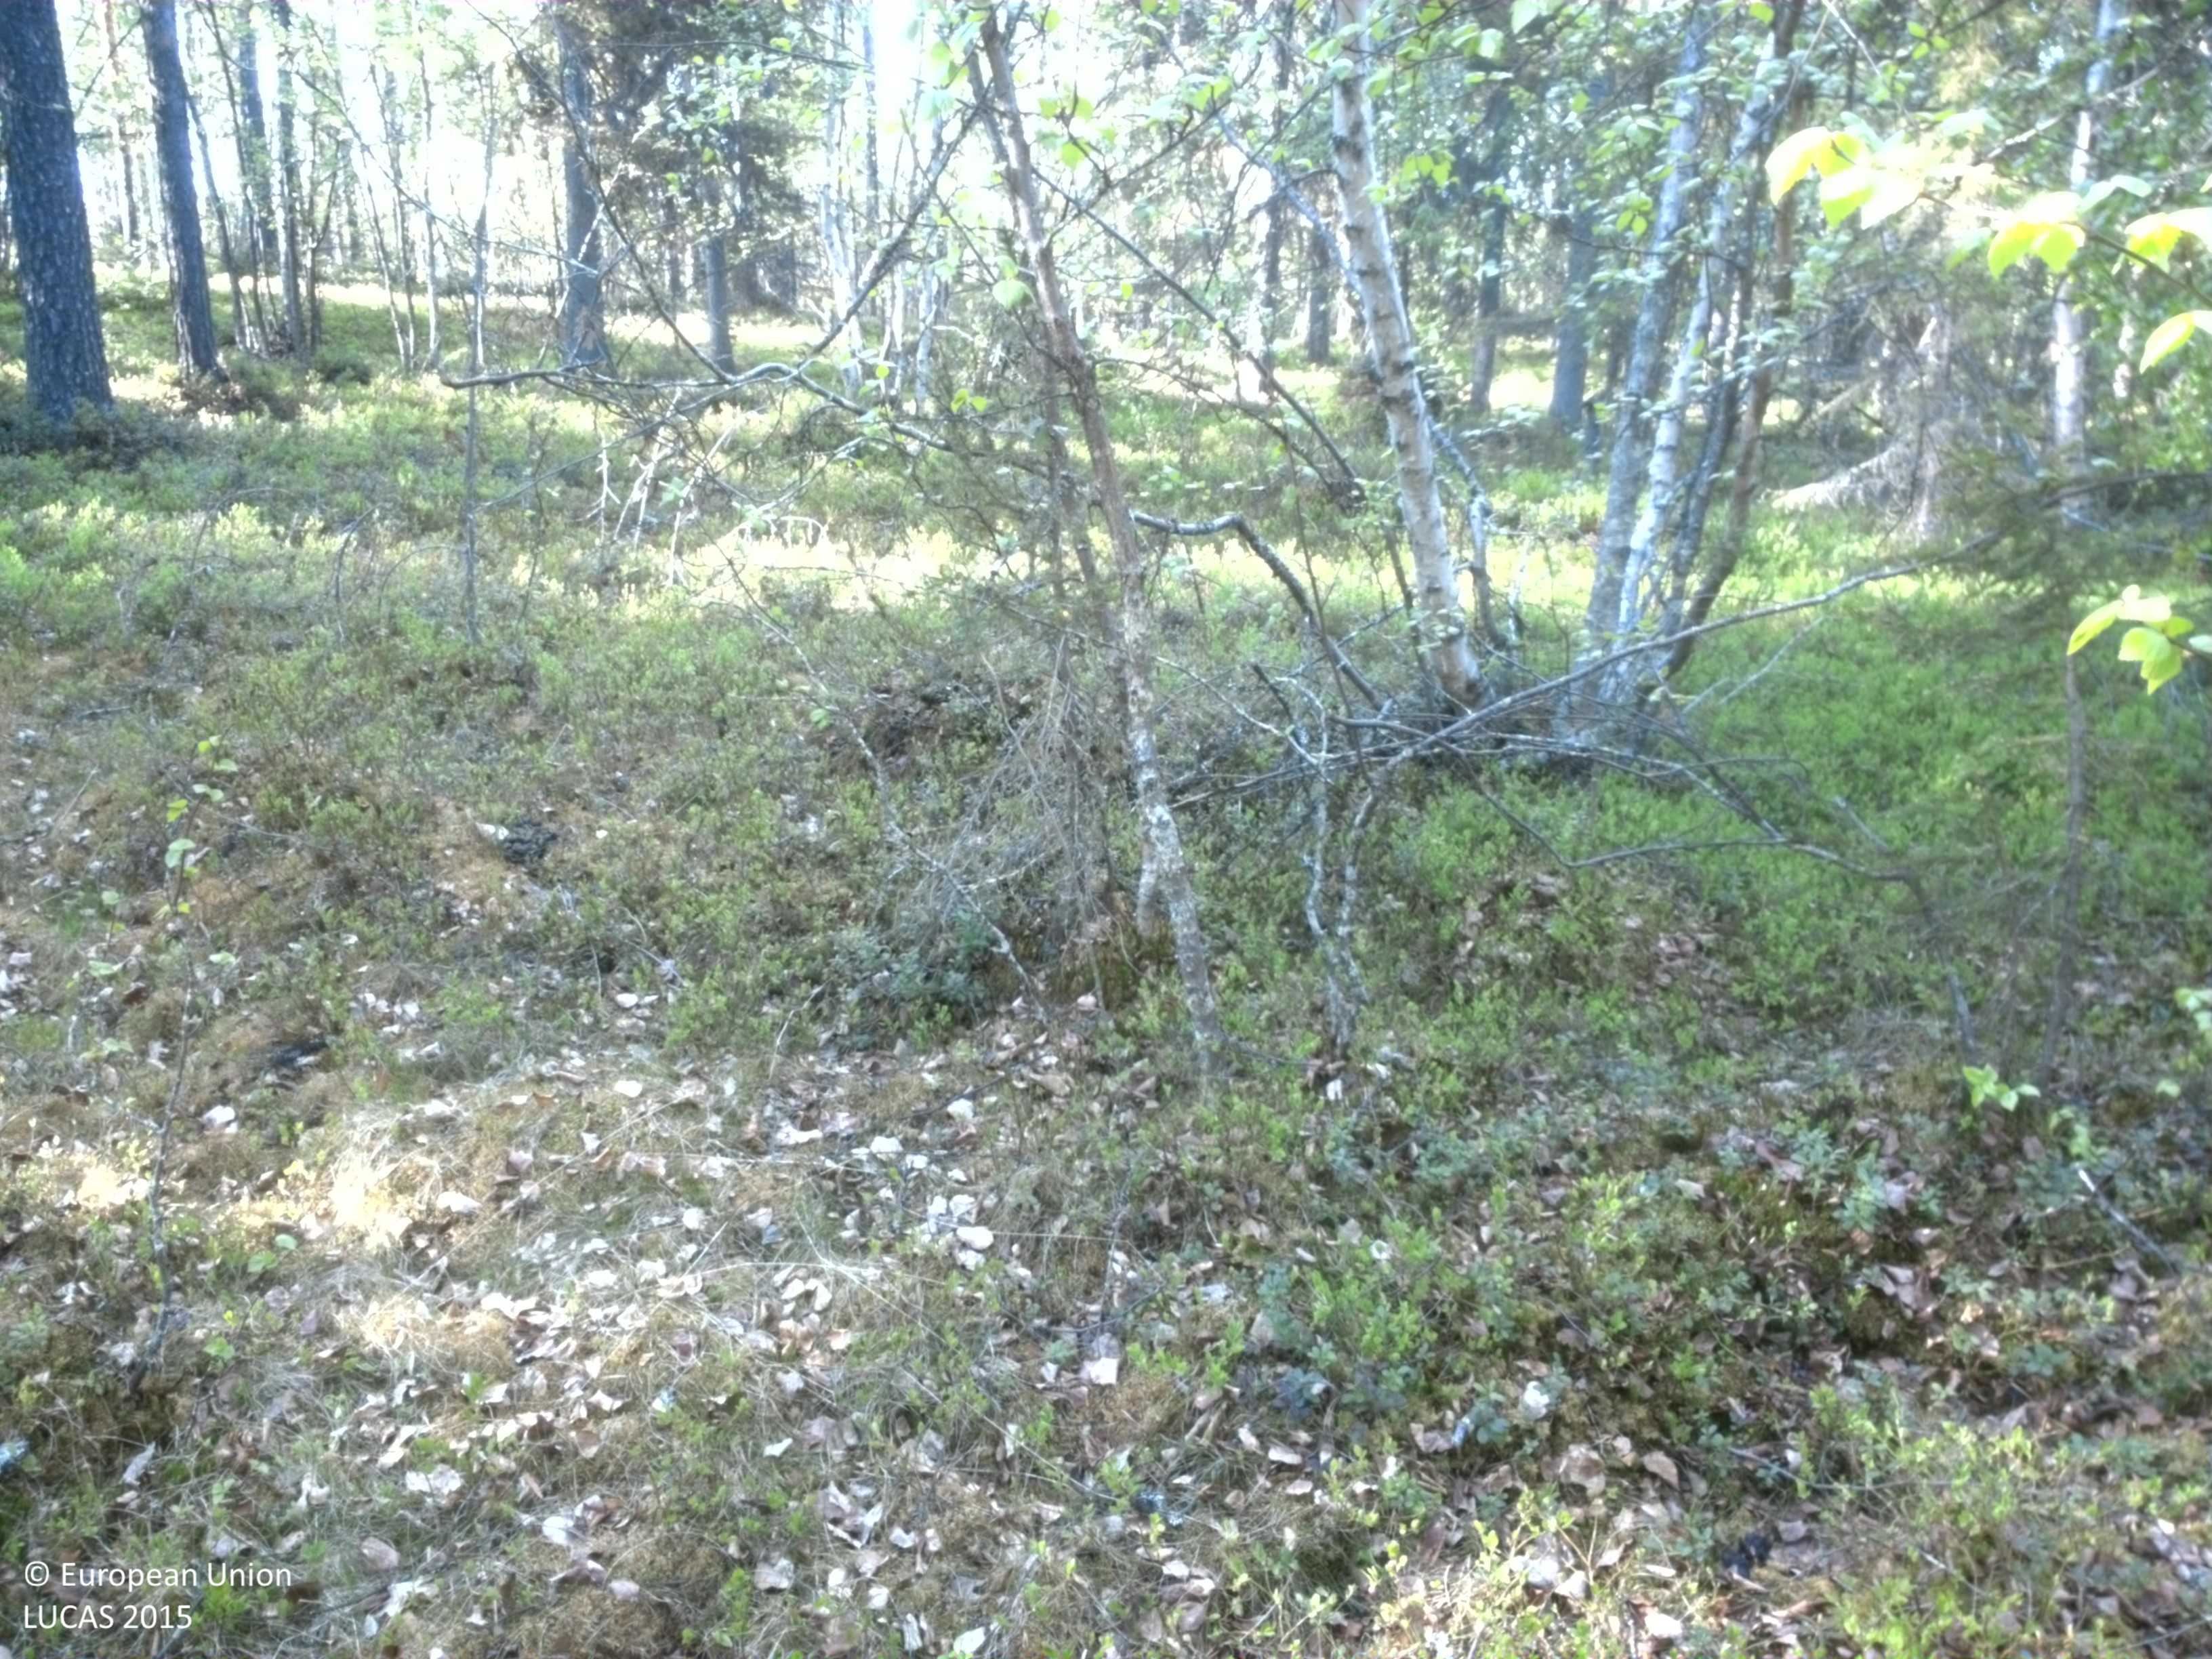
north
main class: Woodland
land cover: Other mixed woodland
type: boreal forest
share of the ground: 25 - 50 %
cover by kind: shrubs 50 %, coniferous forest trees 30 %, broadleaved forest trees 15 %, lichens and mosses 5 %
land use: Forestry
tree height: > 5 m
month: June
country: SE
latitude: 67.0696
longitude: 21.2931
